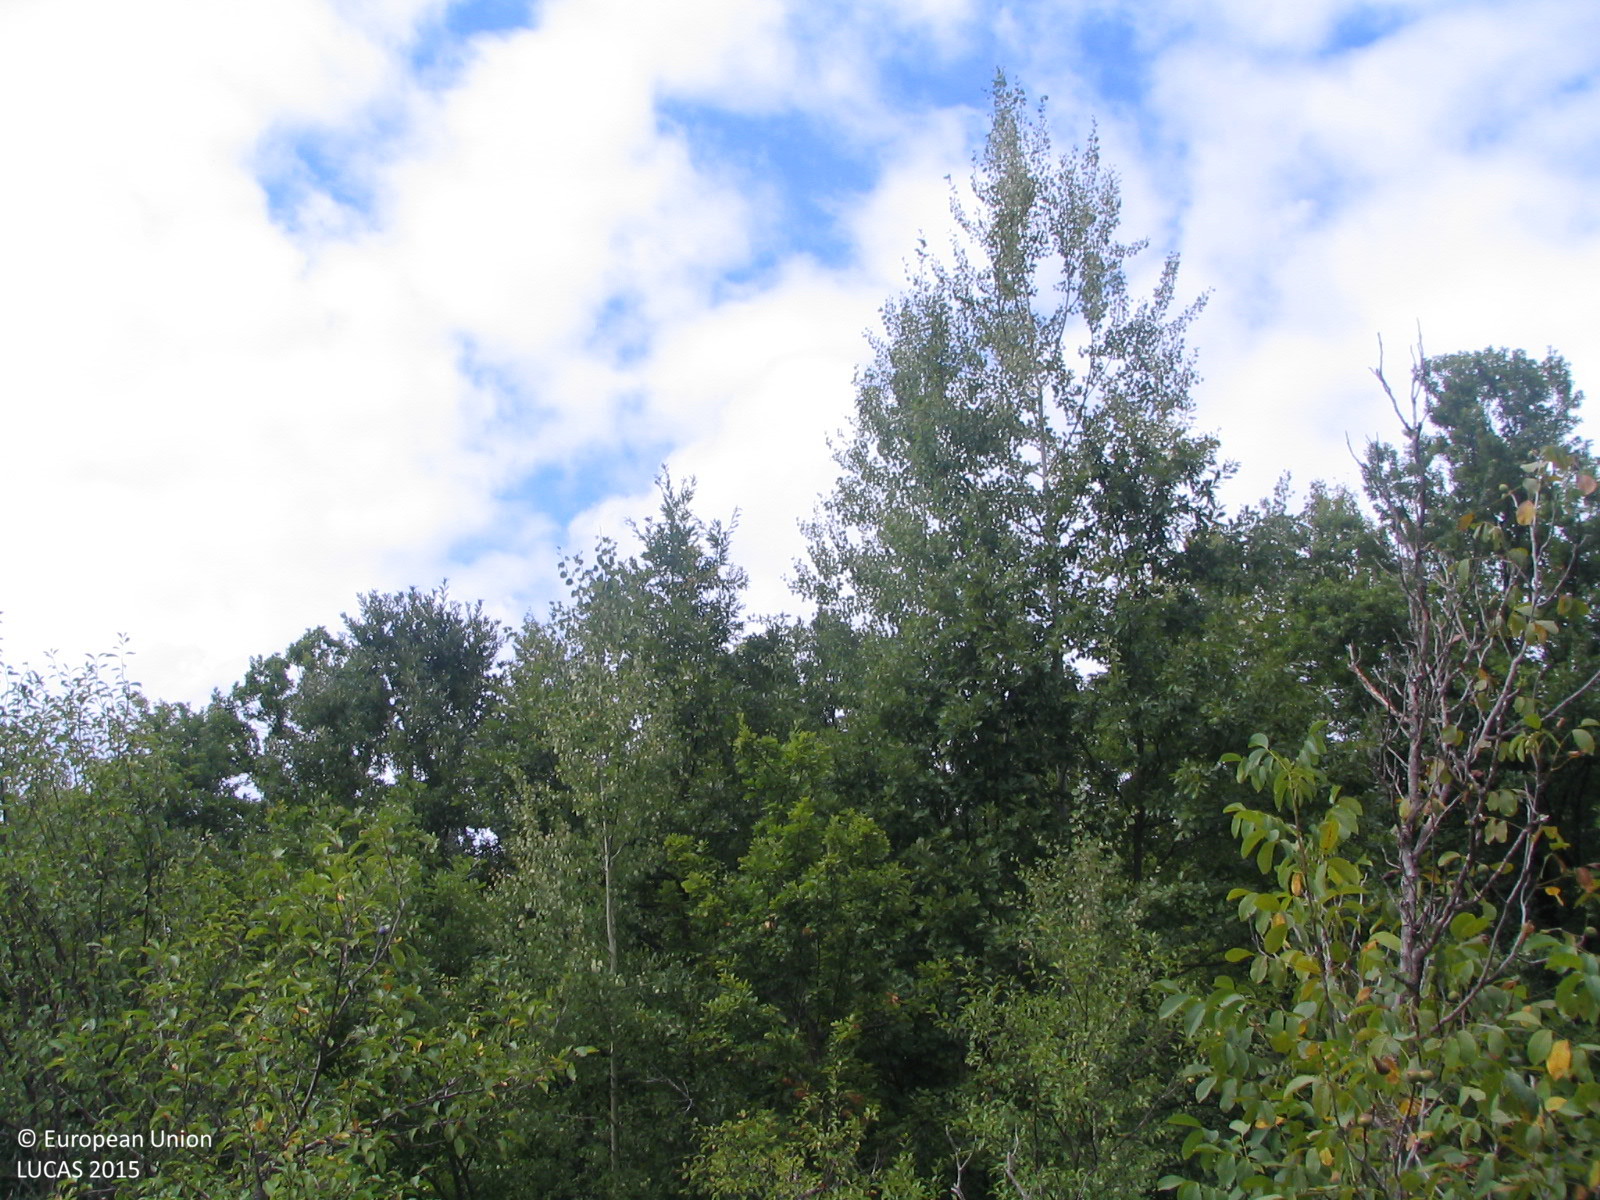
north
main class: Cropland
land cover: Other fruit trees and berries
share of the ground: 50 - 75 %
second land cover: Grassland without tree/shrub cover
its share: > 75 %
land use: Agriculture (excluding fallow land and kitchen gardens)
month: August
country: BG
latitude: 42.8704
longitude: 24.7364
